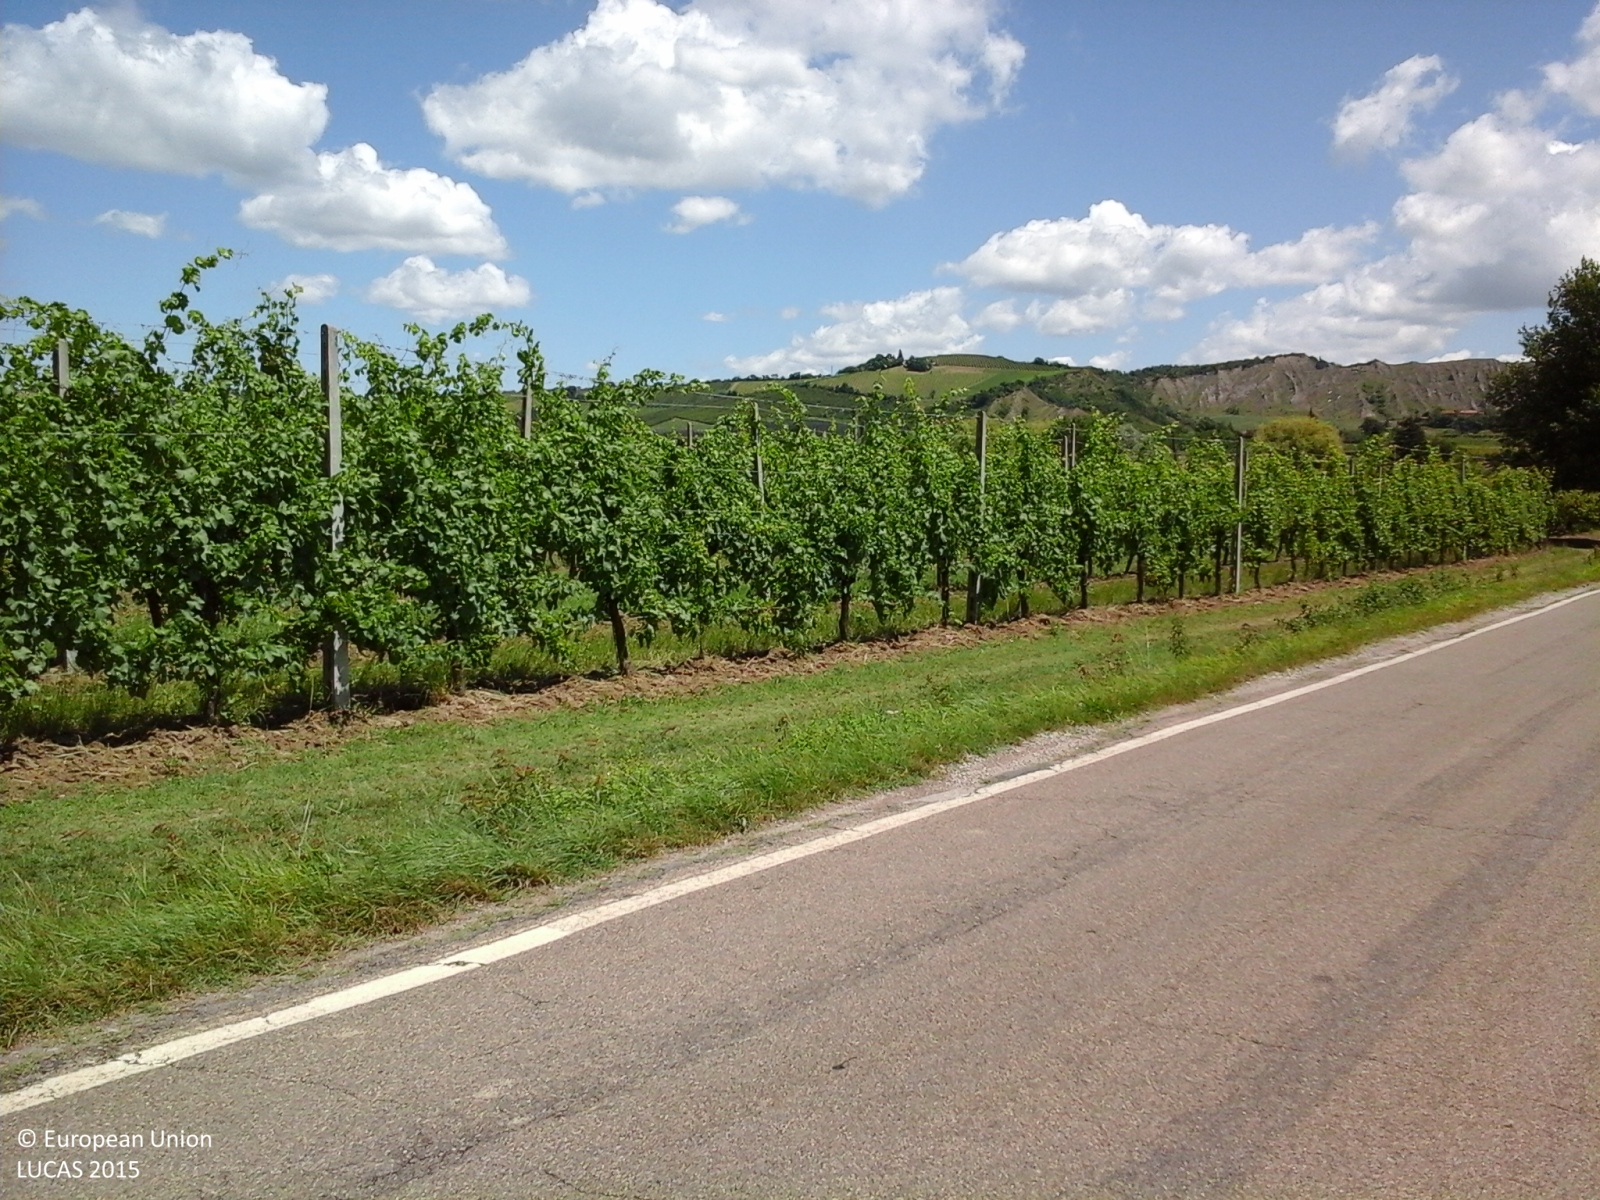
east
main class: Artificial land
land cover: Non built-up linear features
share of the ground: > 75 %
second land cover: Grassland without tree/shrub cover
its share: > 75 %
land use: Road transport
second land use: Agriculture (excluding fallow land and kitchen gardens)
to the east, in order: Artificial constructions in urban areas; Managed hedges; Ditches and canals; Paved roads, cycling and walking lanes; Grass margins; Tracks; Vineyards; Tracks; Grass margins; Ditches and canals; Other fruit trees and berries; Ditches and canals; Tracks; Ditches and canals; Grass margins; Ditches and canals; Grass margins; Tracks; Electric lines; Vineyards
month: June
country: IT
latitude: 44.3015
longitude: 11.6383
